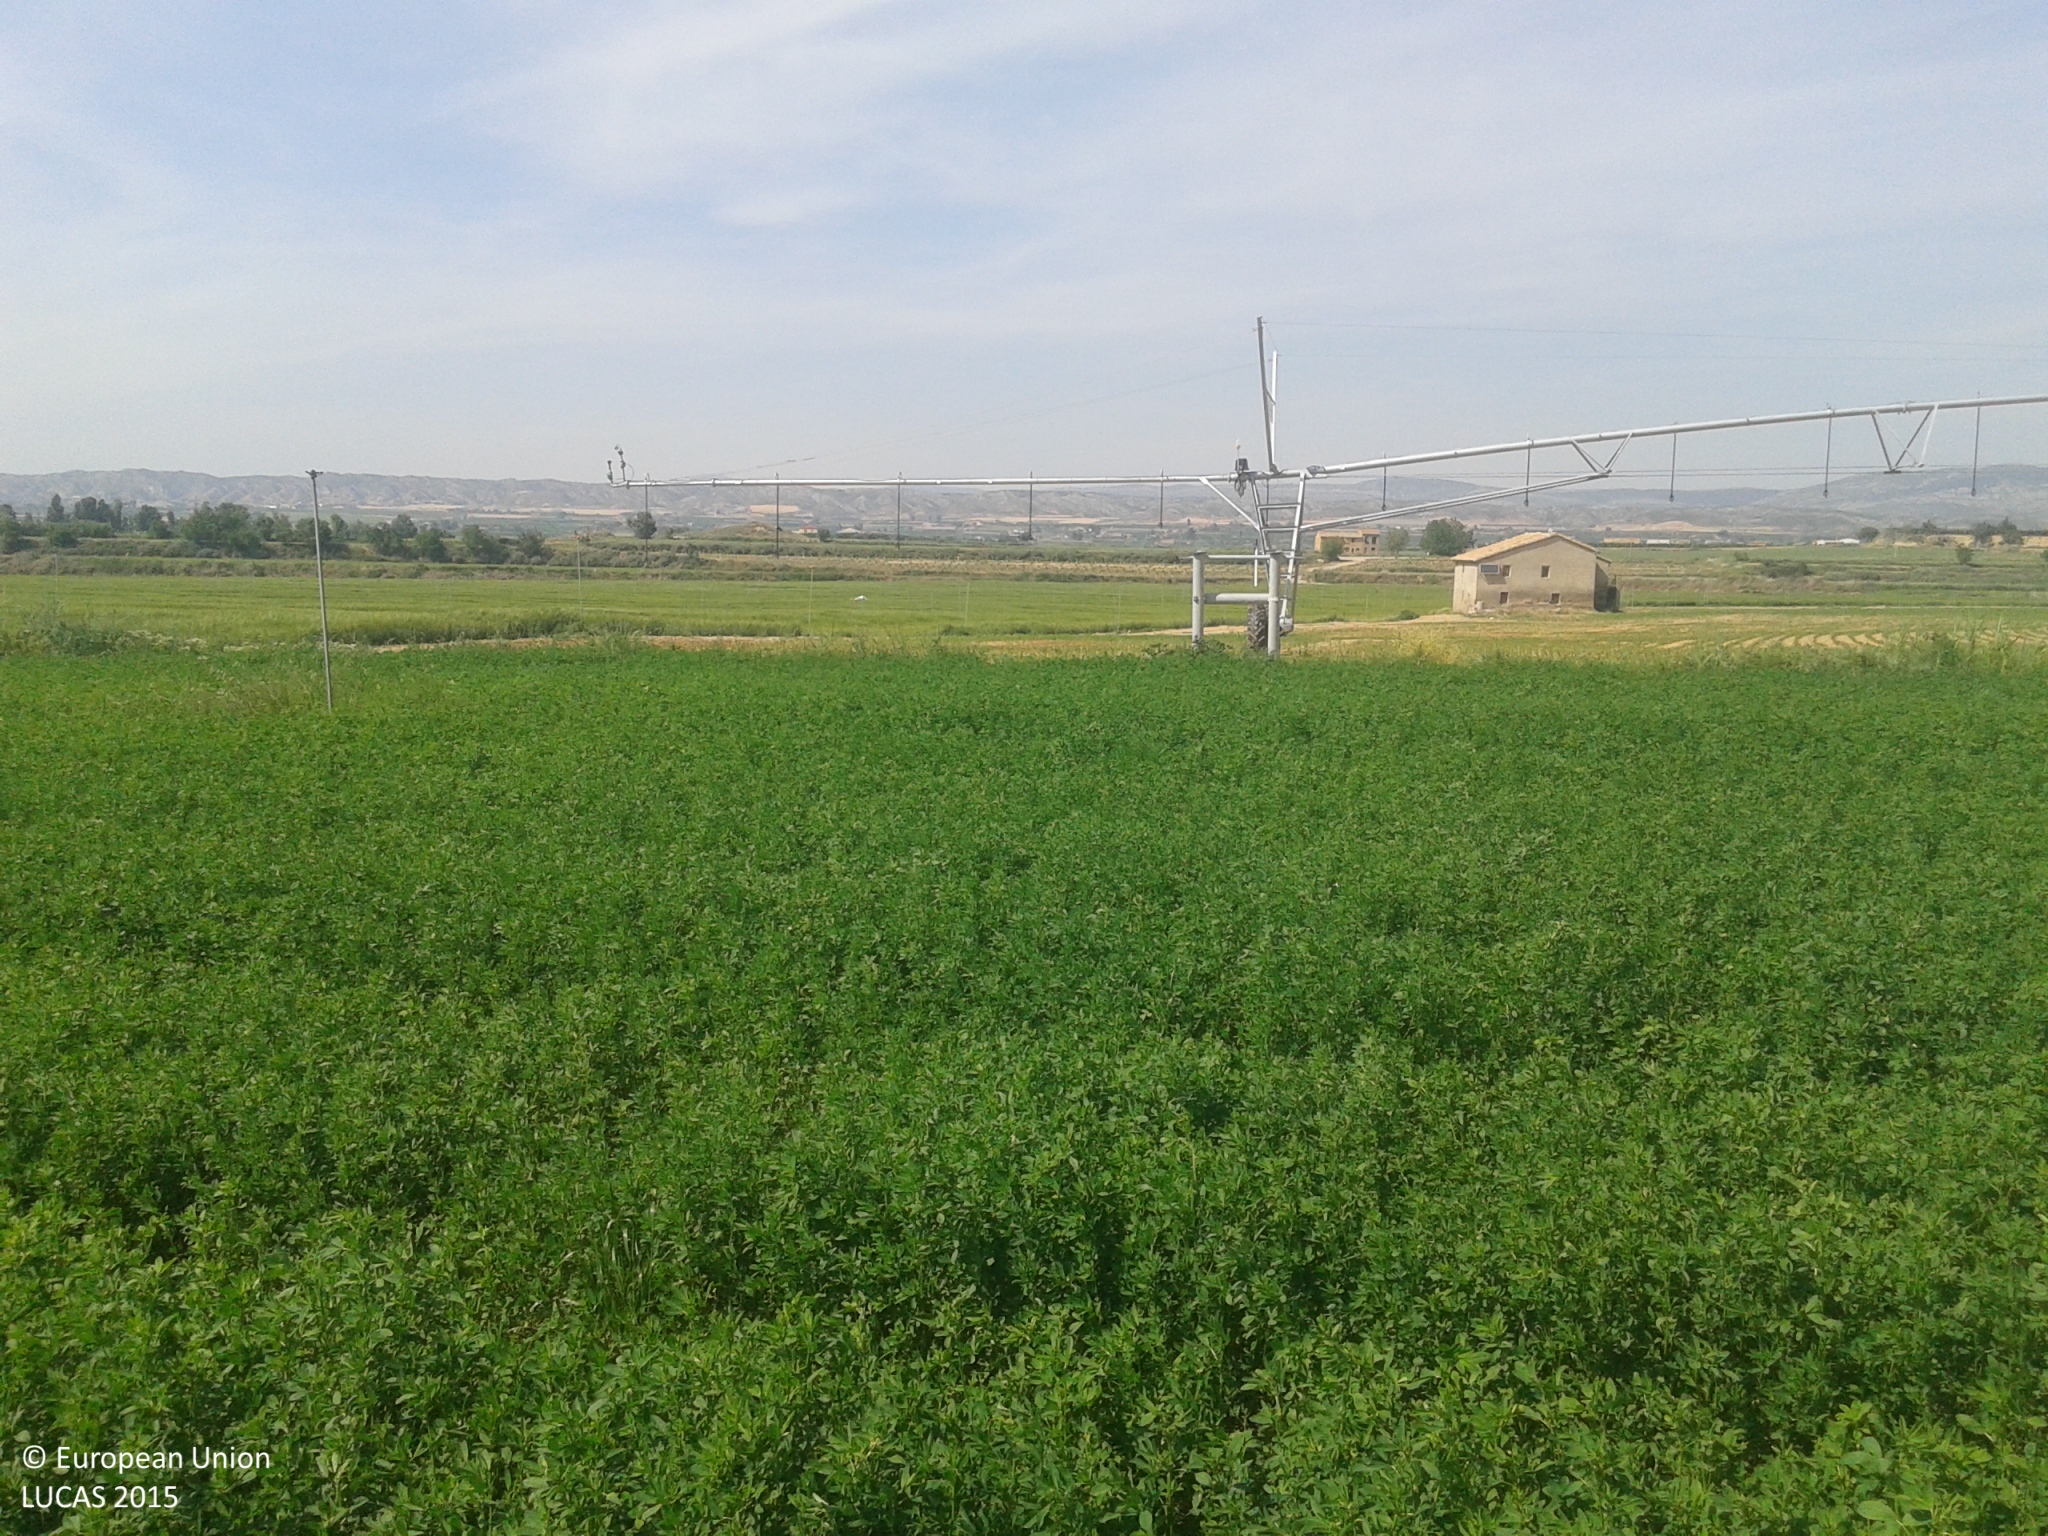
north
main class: Cropland
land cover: Lucerne
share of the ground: > 75 %
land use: Agriculture (excluding fallow land and kitchen gardens)
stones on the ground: < 10 %
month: May
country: ES
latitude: 41.8079
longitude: 0.5128
